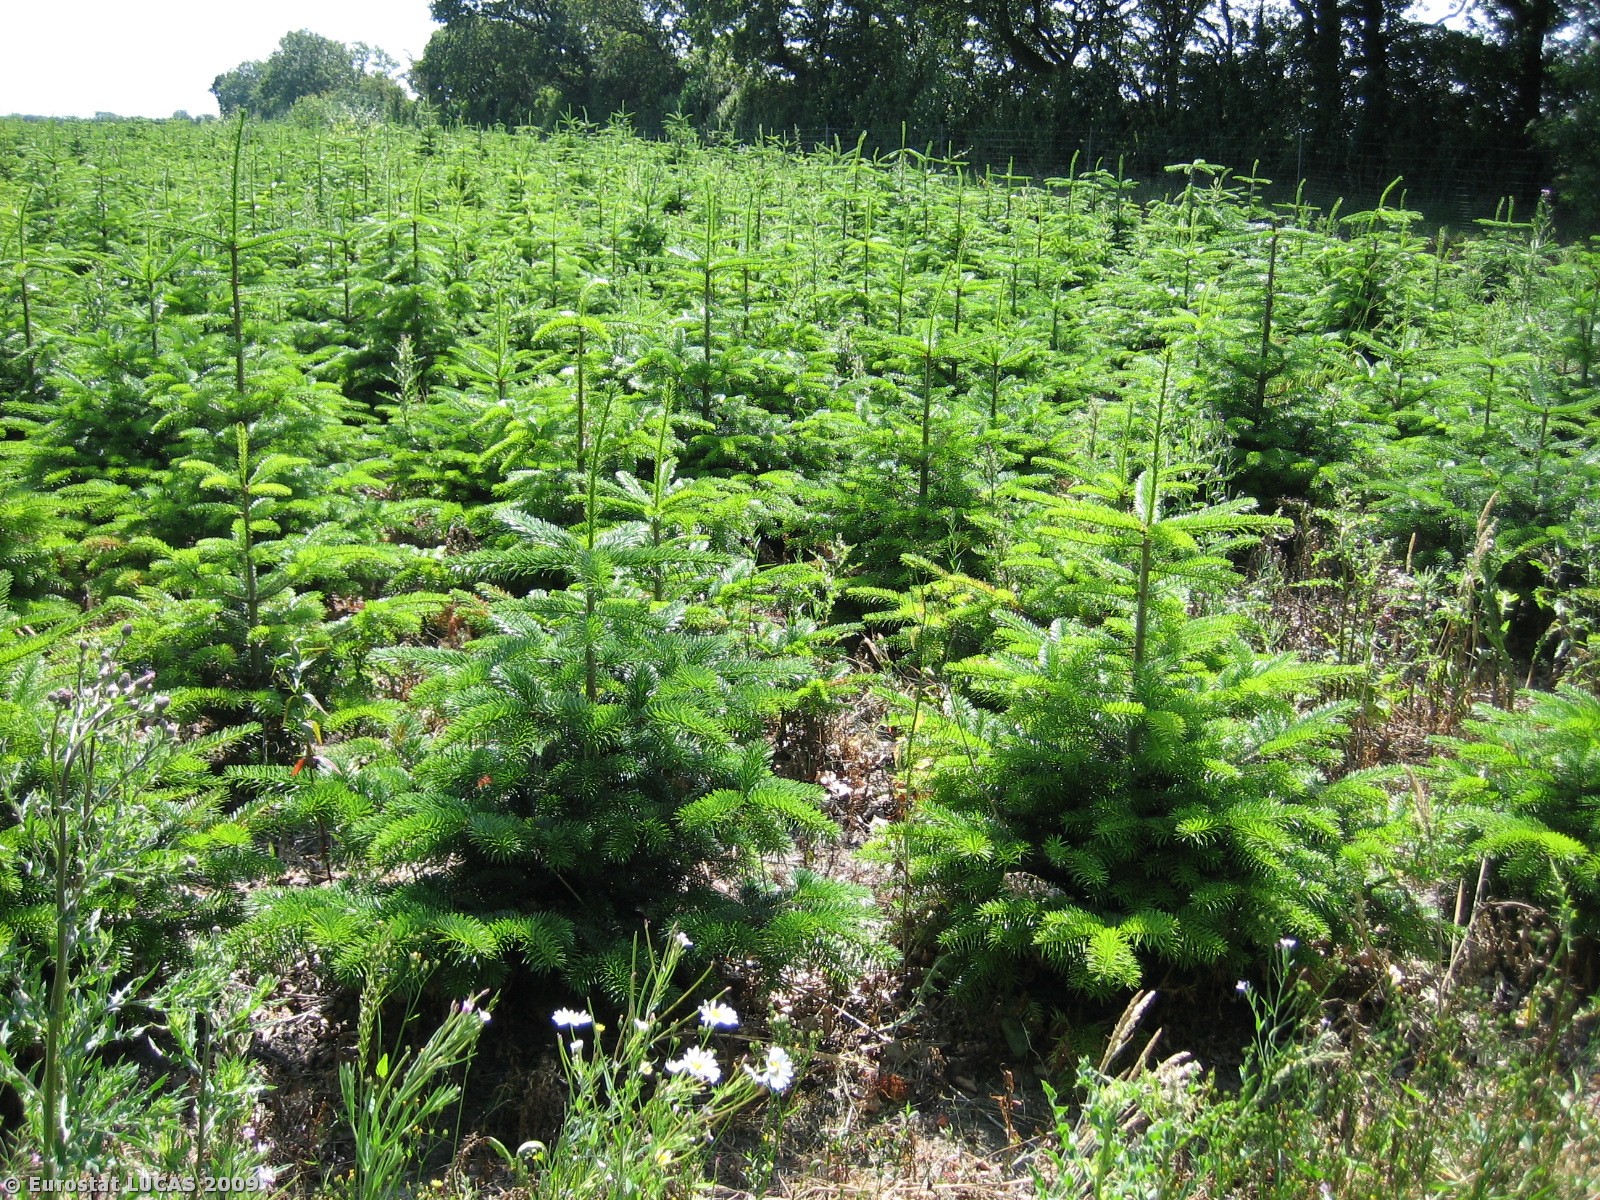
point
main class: Woodland
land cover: Coniferous woodland
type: hemiboreal forest and nemoral coniferous forest and mixed broadleaved-coniferous forest
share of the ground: 50 - 75 %
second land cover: Spontaneously vegetated surfaces
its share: 25 - 50 %
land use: Forestry
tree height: > 5 m
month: July
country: DK
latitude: 55.3589
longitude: 9.2908
